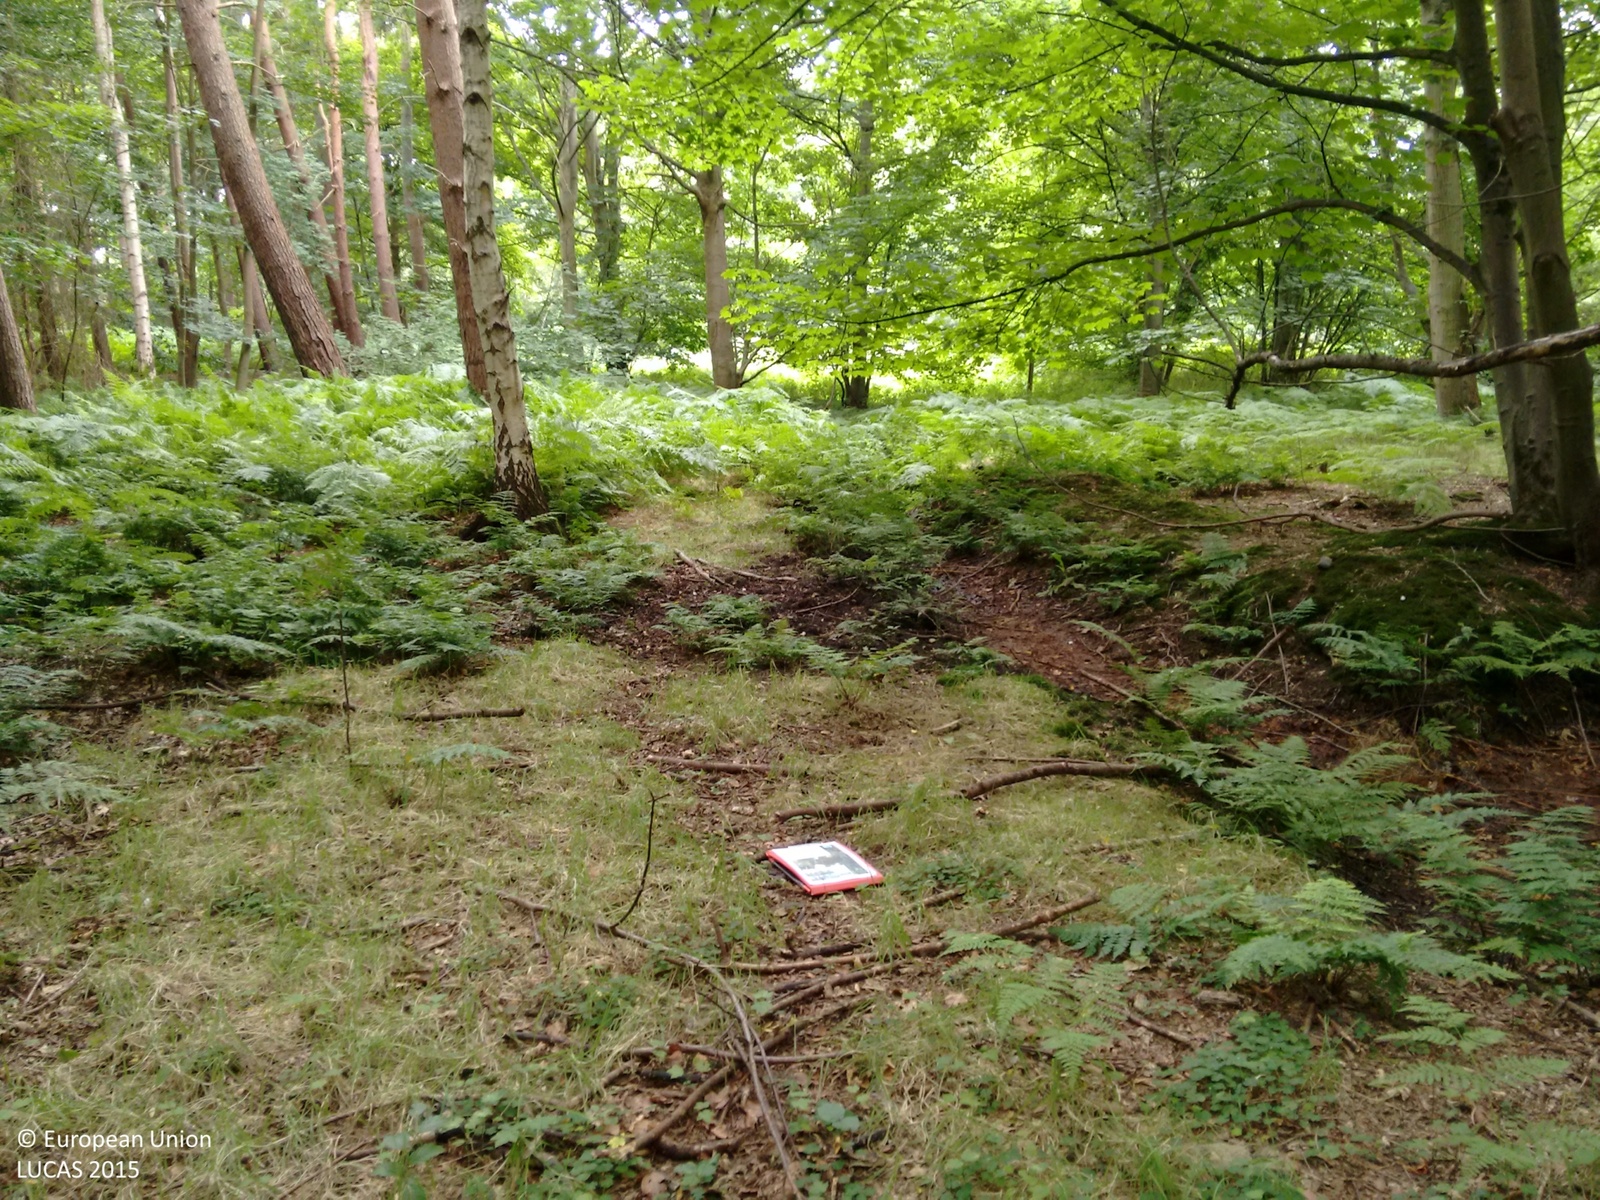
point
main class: Woodland
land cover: Broadleaved woodland
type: mesophytic deciduous forest
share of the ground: > 75 %
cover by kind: broadleaved forest trees 100 %
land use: Forestry
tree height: > 5 m
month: August
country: GB
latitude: 52.6403
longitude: 0.4104
